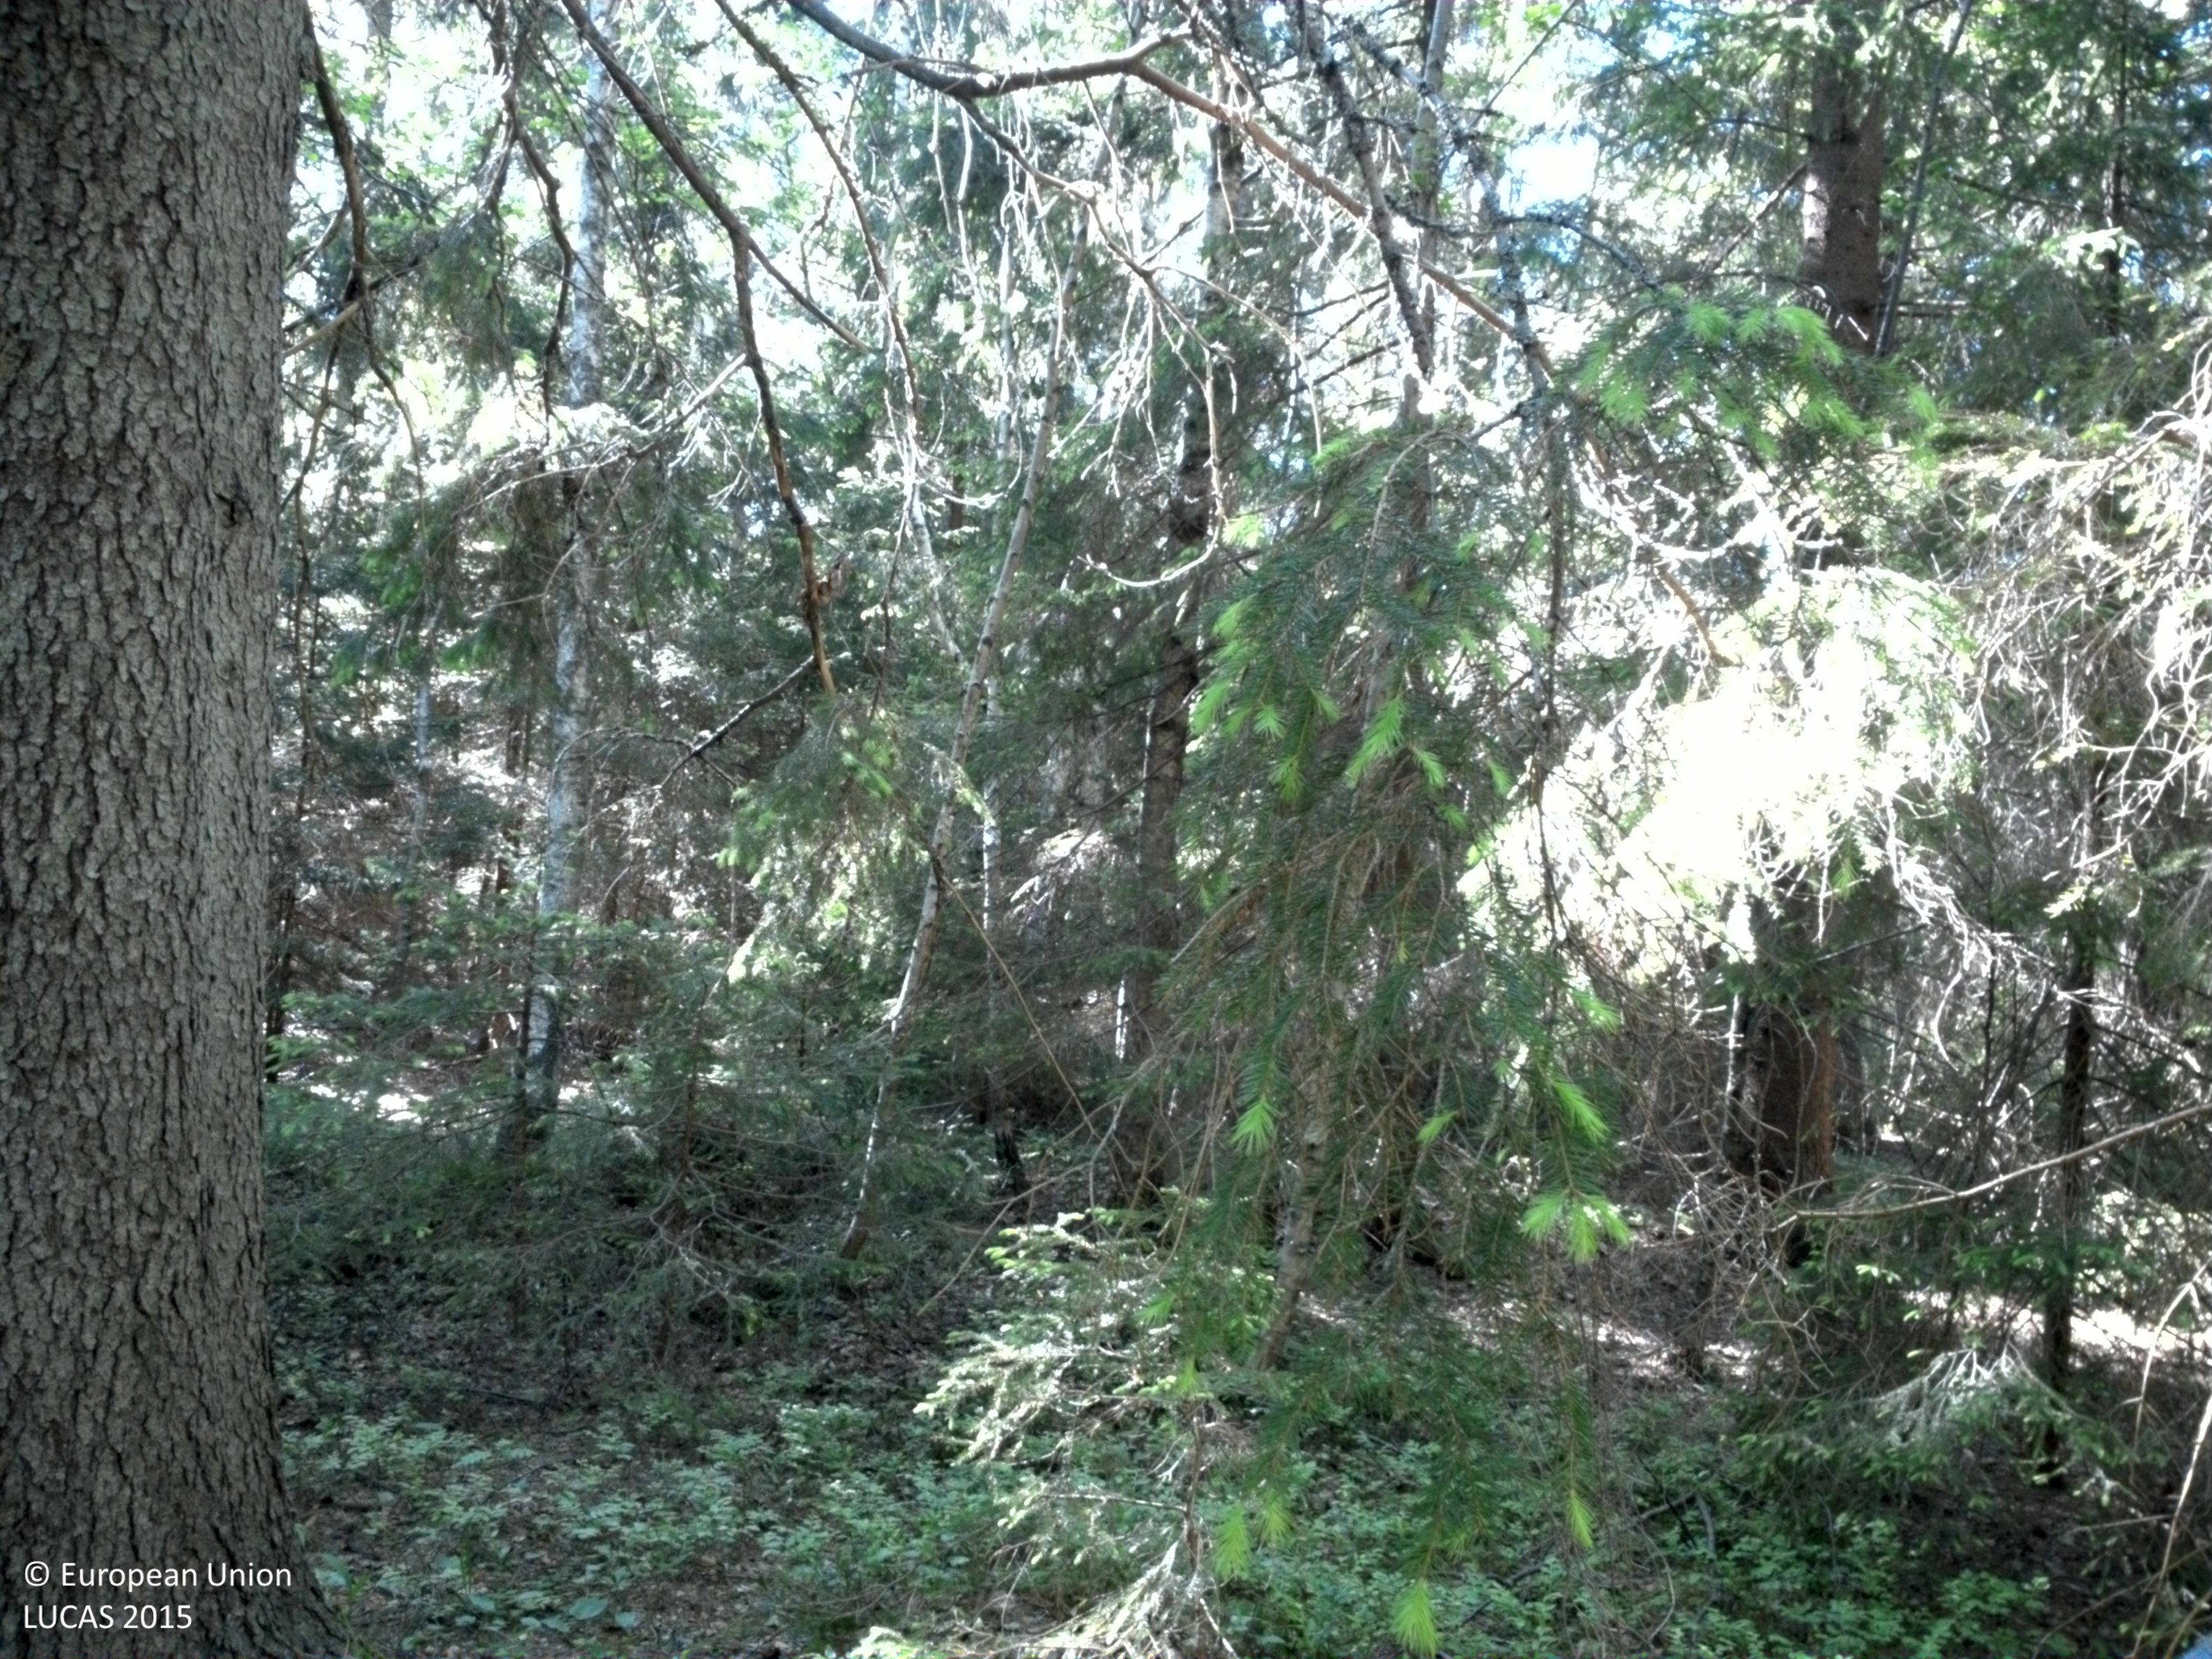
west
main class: Woodland
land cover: Spruce dominated mixed woodland
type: boreal forest
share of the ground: > 75 %
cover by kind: coniferous forest trees 60 %, broadleaved forest trees 20 %, shrubs 10 %, herbaceous plants 10 %
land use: Forestry
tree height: > 5 m
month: June
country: SE
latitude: 59.9736
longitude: 18.8682
